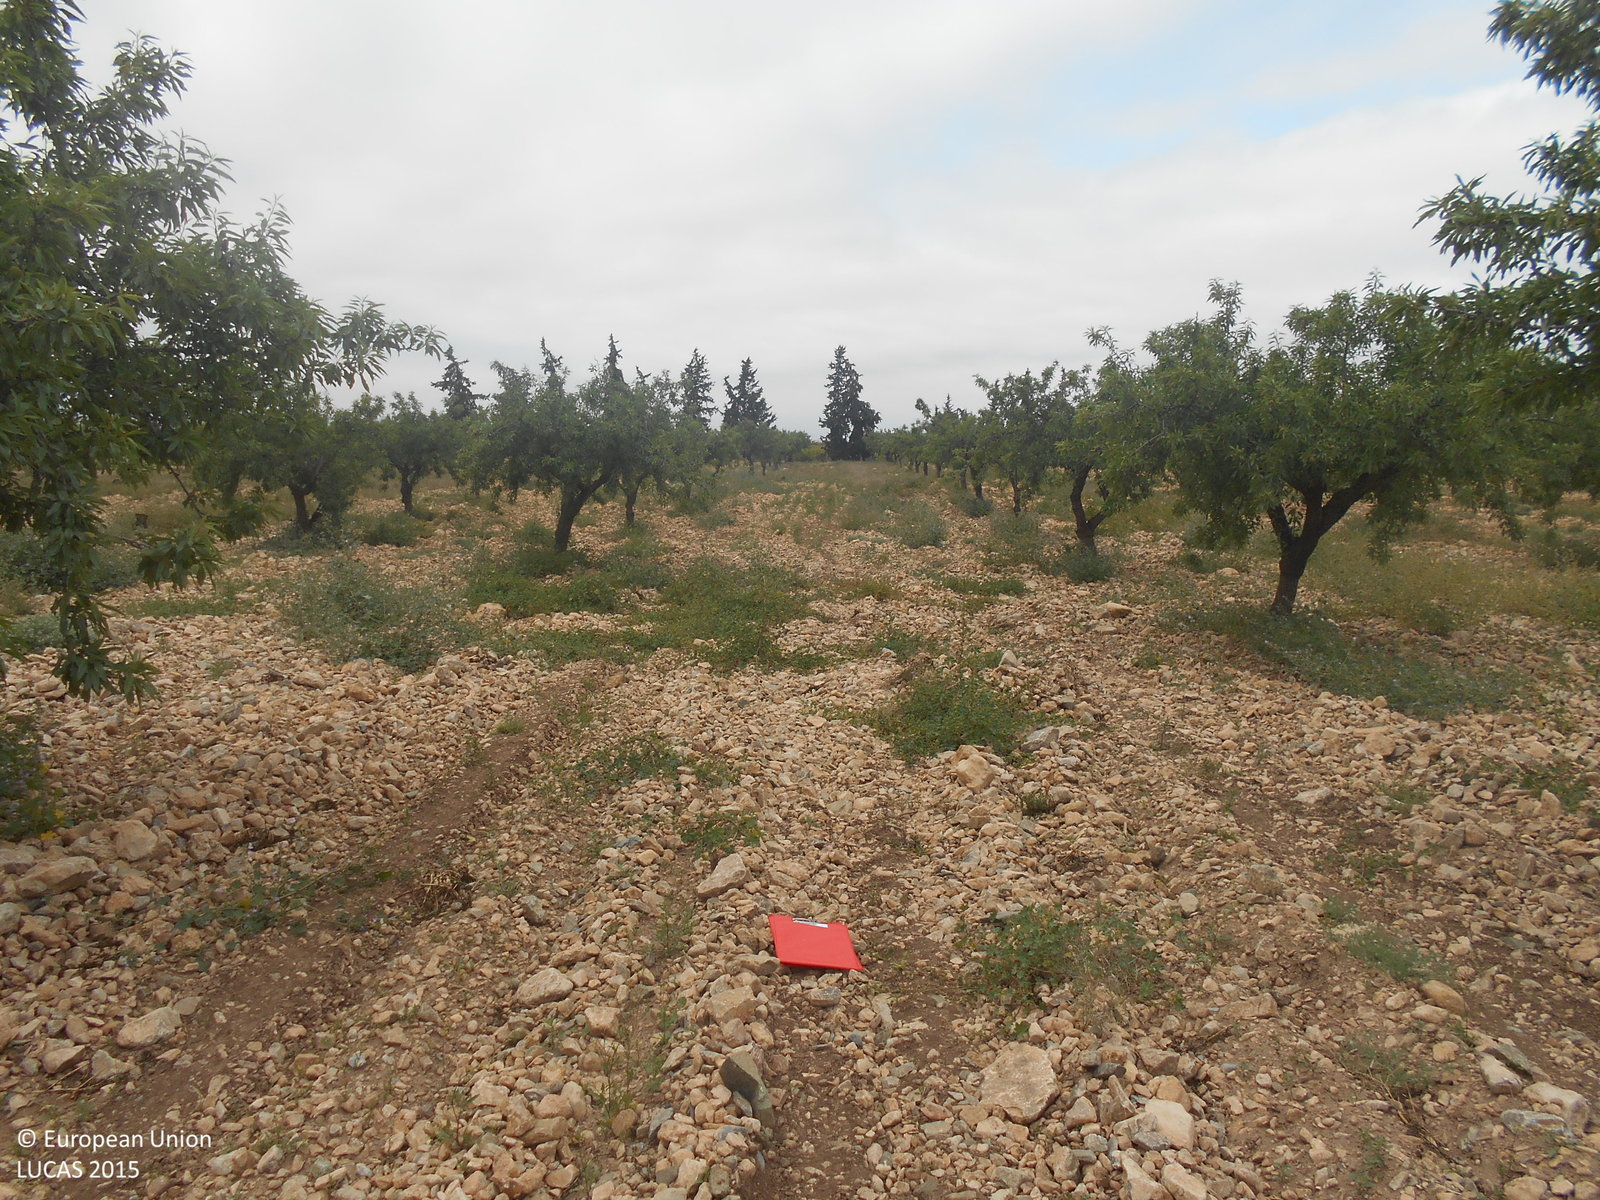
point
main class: Cropland
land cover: Nuts trees
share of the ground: 25 - 50 %
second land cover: Other bare soil
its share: > 75 %
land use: Agriculture (excluding fallow land and kitchen gardens)
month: April
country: ES
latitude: 37.7902
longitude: -1.2581
